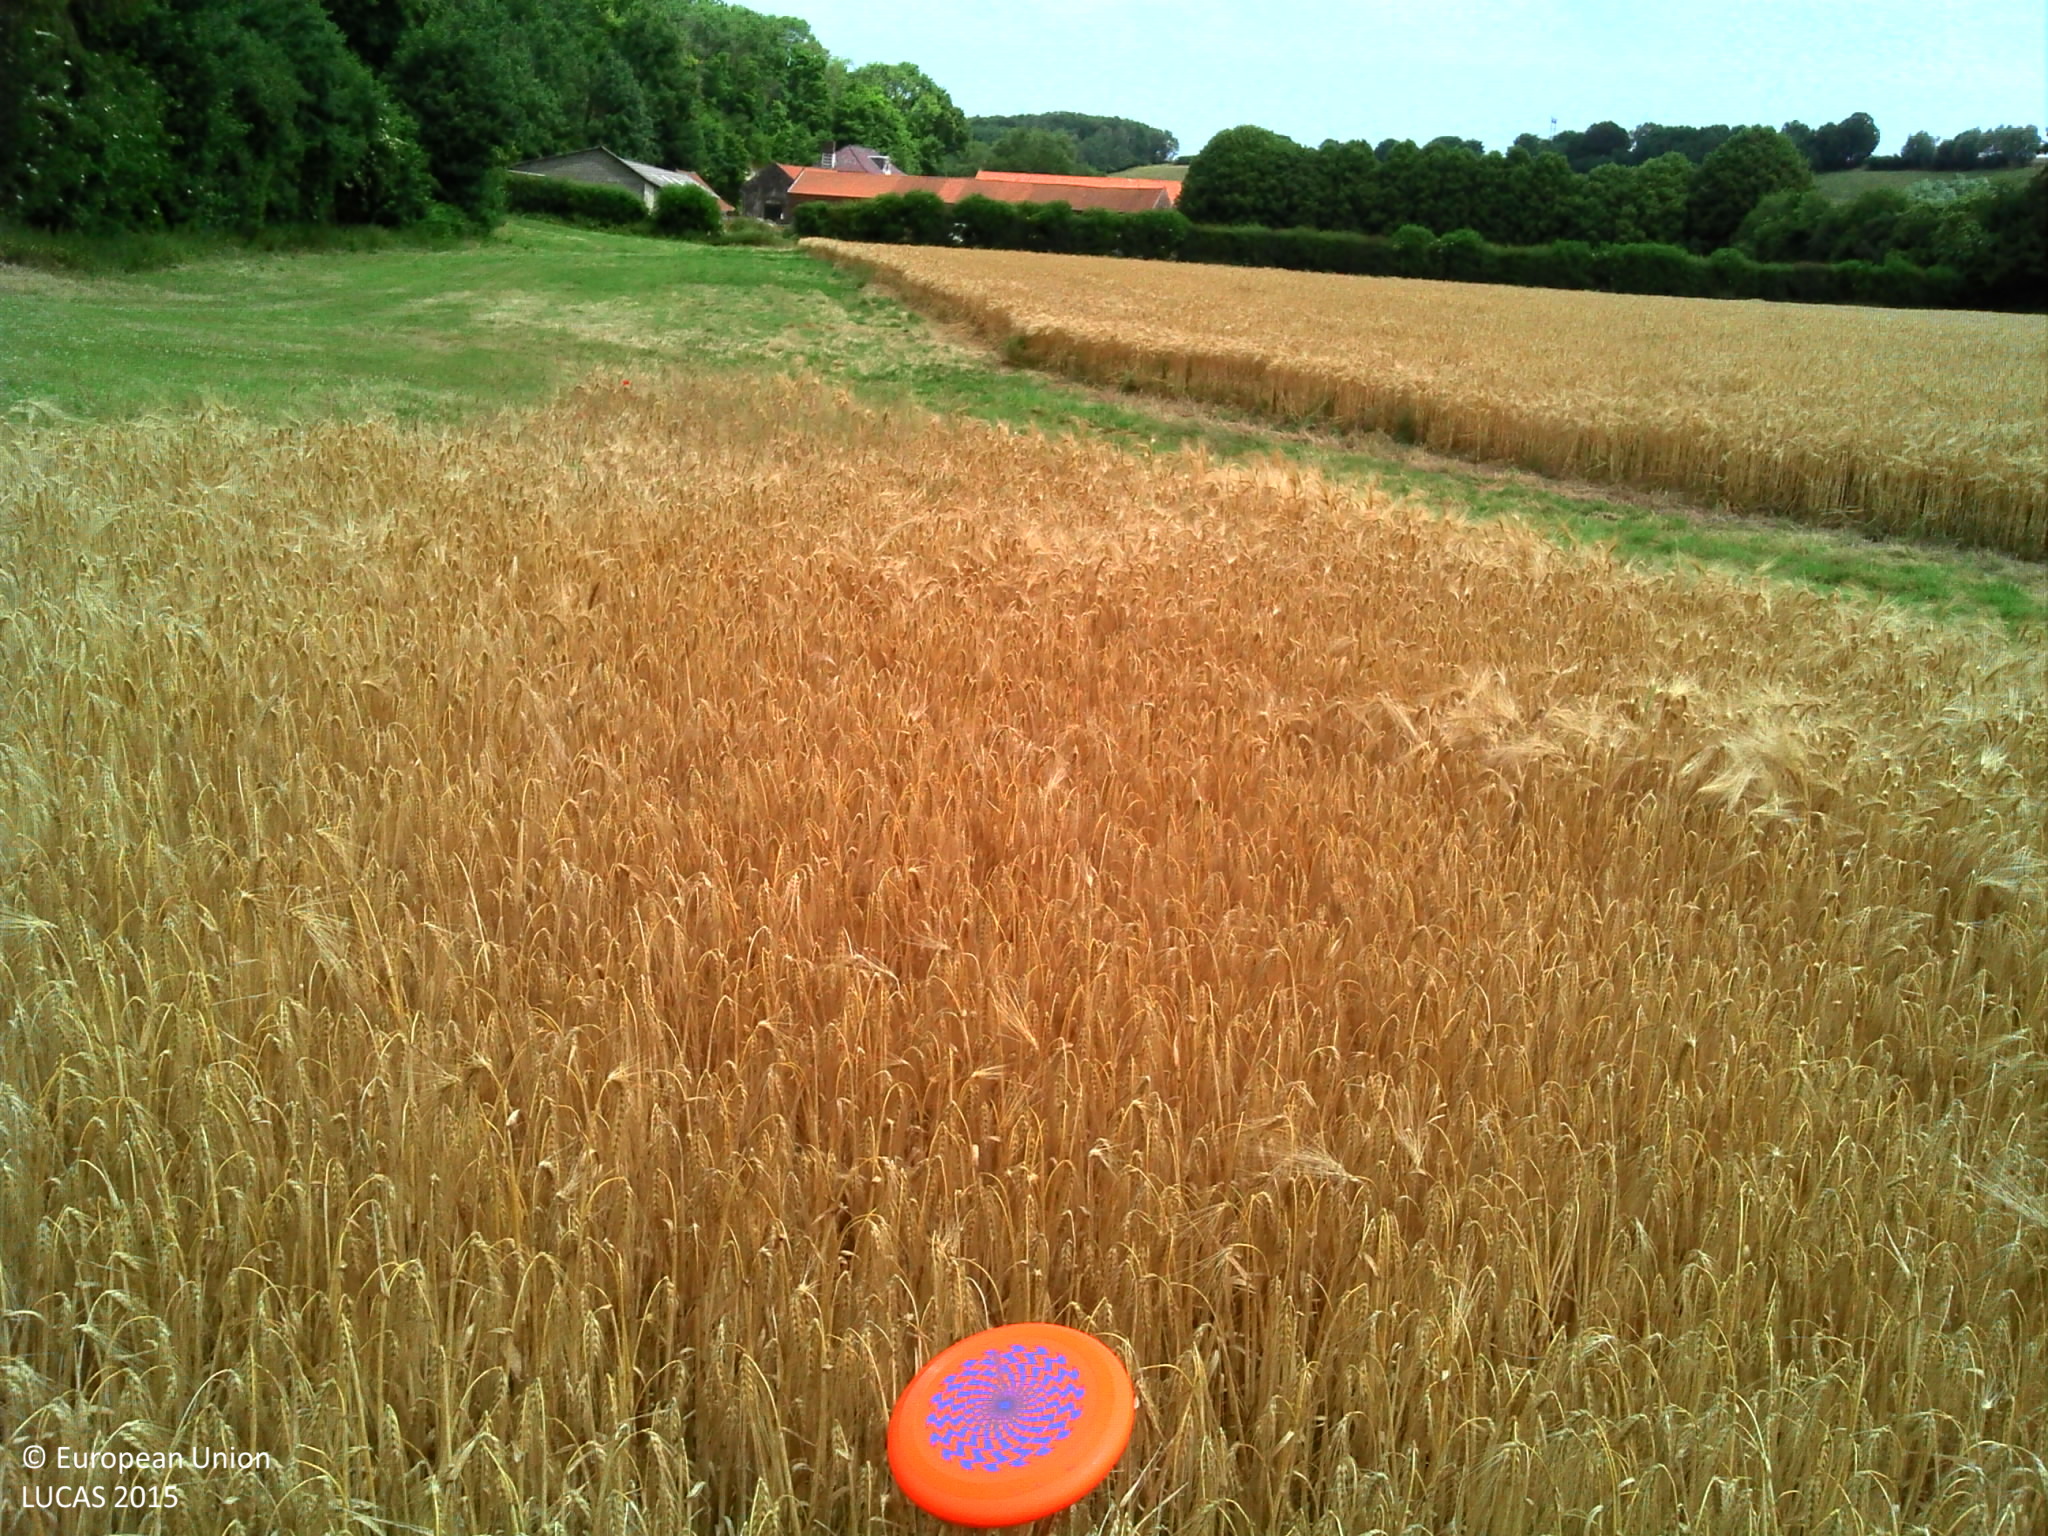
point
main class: Cropland
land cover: Barley
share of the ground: > 75 %
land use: Agriculture (excluding fallow land and kitchen gardens)
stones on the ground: < 10 %
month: July
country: FR
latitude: 50.4170
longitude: 2.1179
